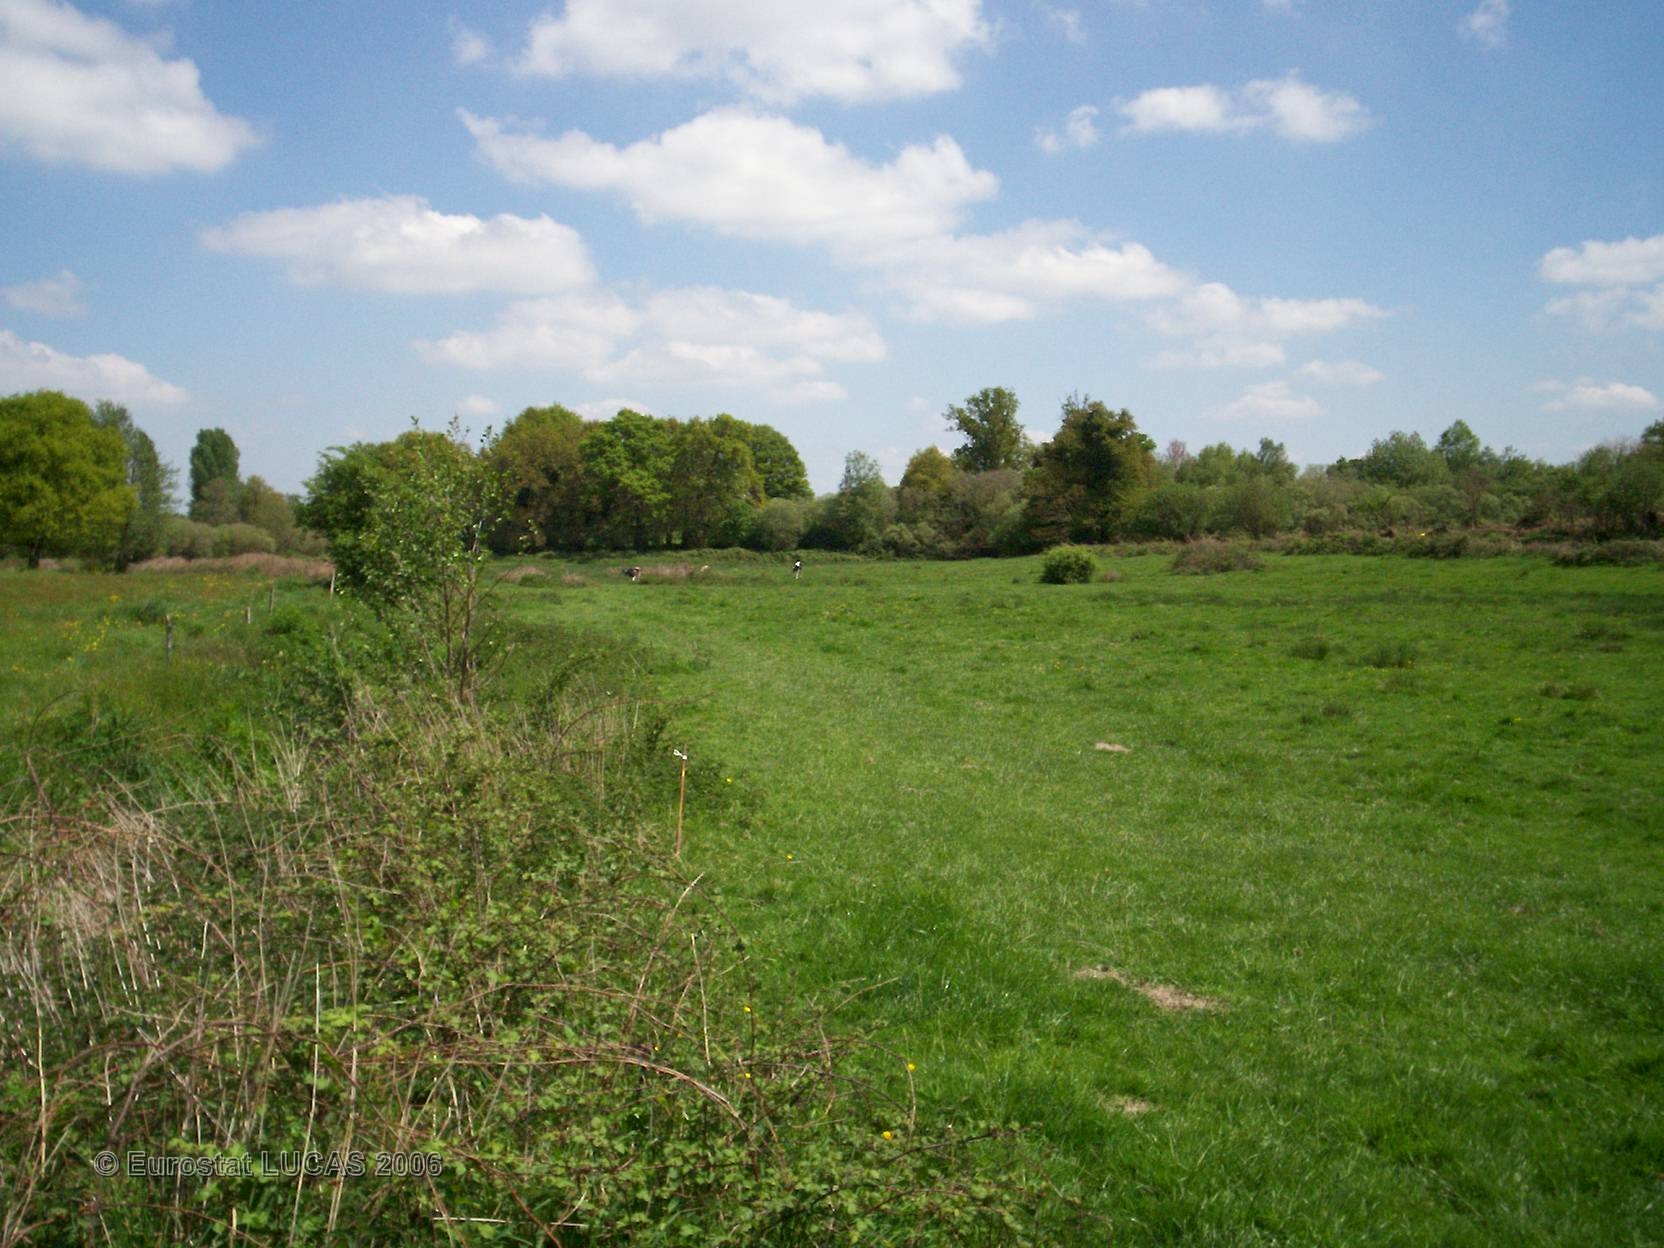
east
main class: Grassland
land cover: Grassland without tree/shrub cover
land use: Agriculture (excluding fallow land and kitchen gardens)
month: May
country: FR
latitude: 47.6099
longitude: -2.2526
